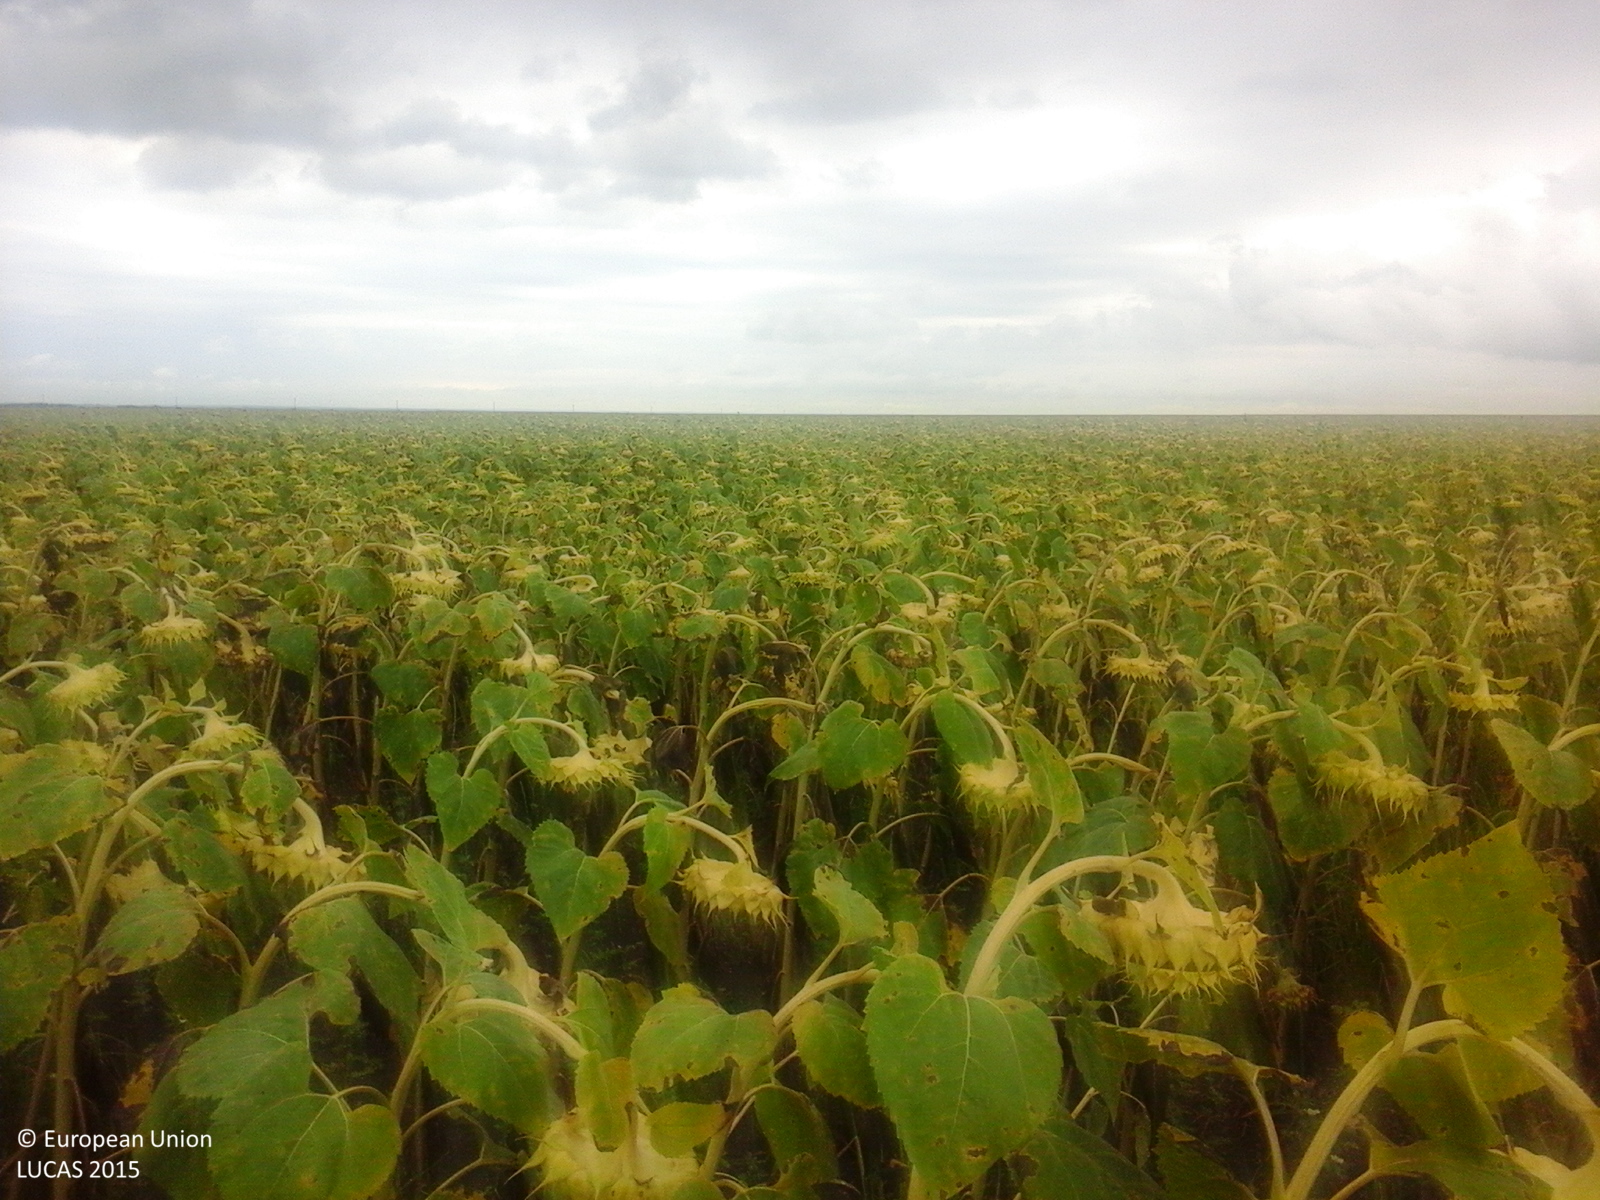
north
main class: Cropland
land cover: Sunflower
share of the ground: > 75 %
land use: Agriculture (excluding fallow land and kitchen gardens)
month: August
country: RO
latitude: 45.5773
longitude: 21.5542
